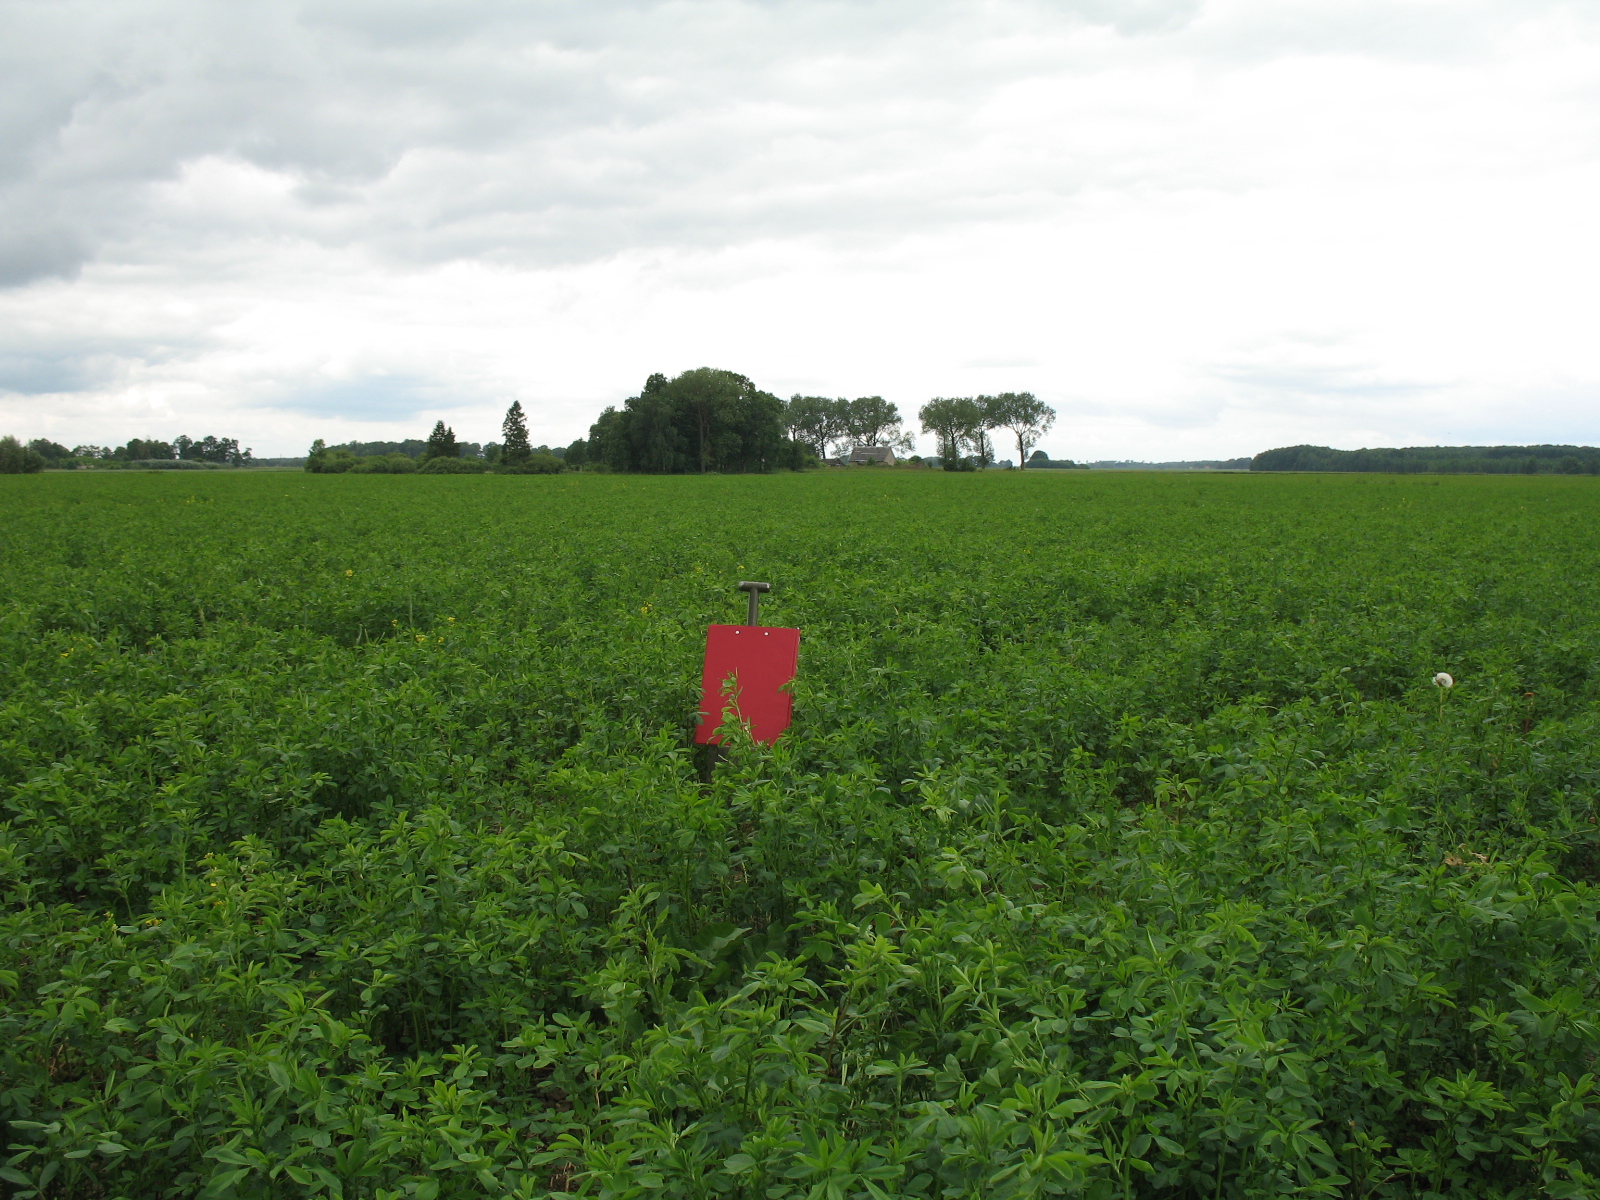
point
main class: Cropland
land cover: Lucerne
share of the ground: > 75 %
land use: Agriculture (excluding fallow land and kitchen gardens)
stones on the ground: < 10 %
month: June
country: LV
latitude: 56.5480
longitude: 23.4941
